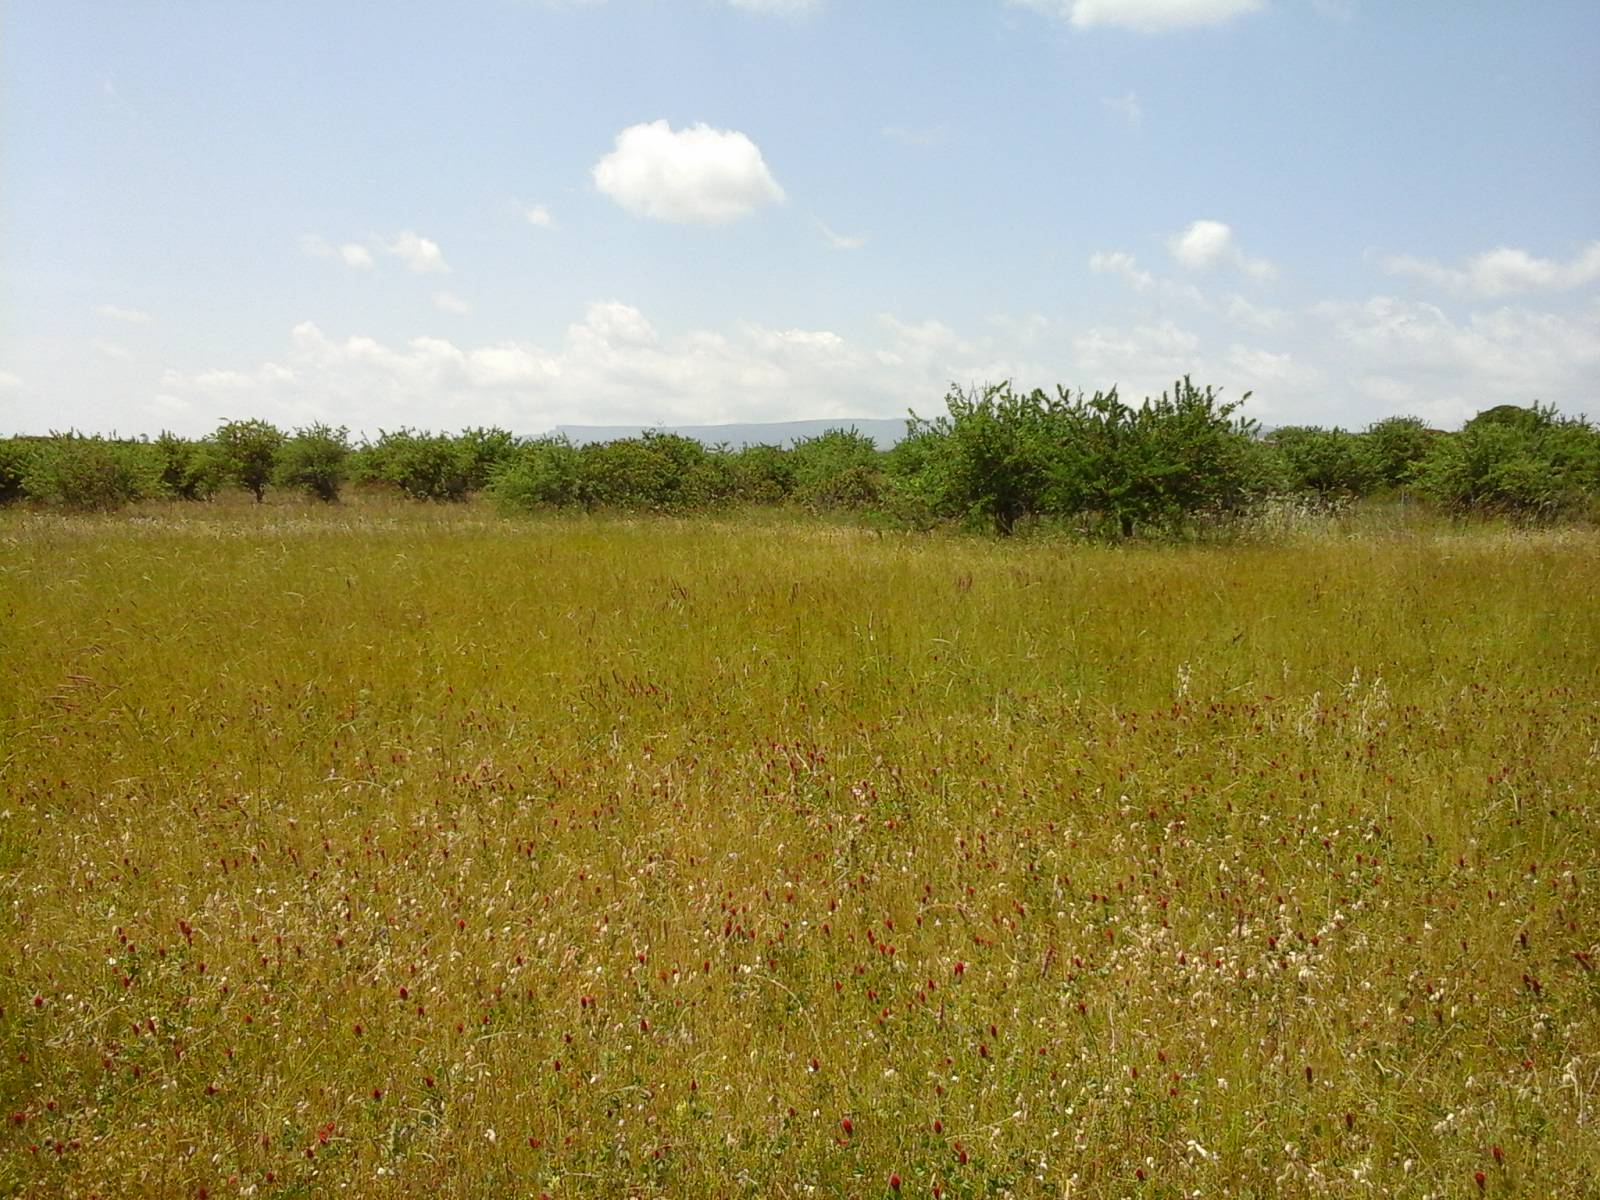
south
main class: Cropland
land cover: Other leguminous and mixtures for fodder
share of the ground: > 75 %
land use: Agriculture (excluding fallow land and kitchen gardens)
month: May
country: IT
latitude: 39.8265
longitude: 8.8963
